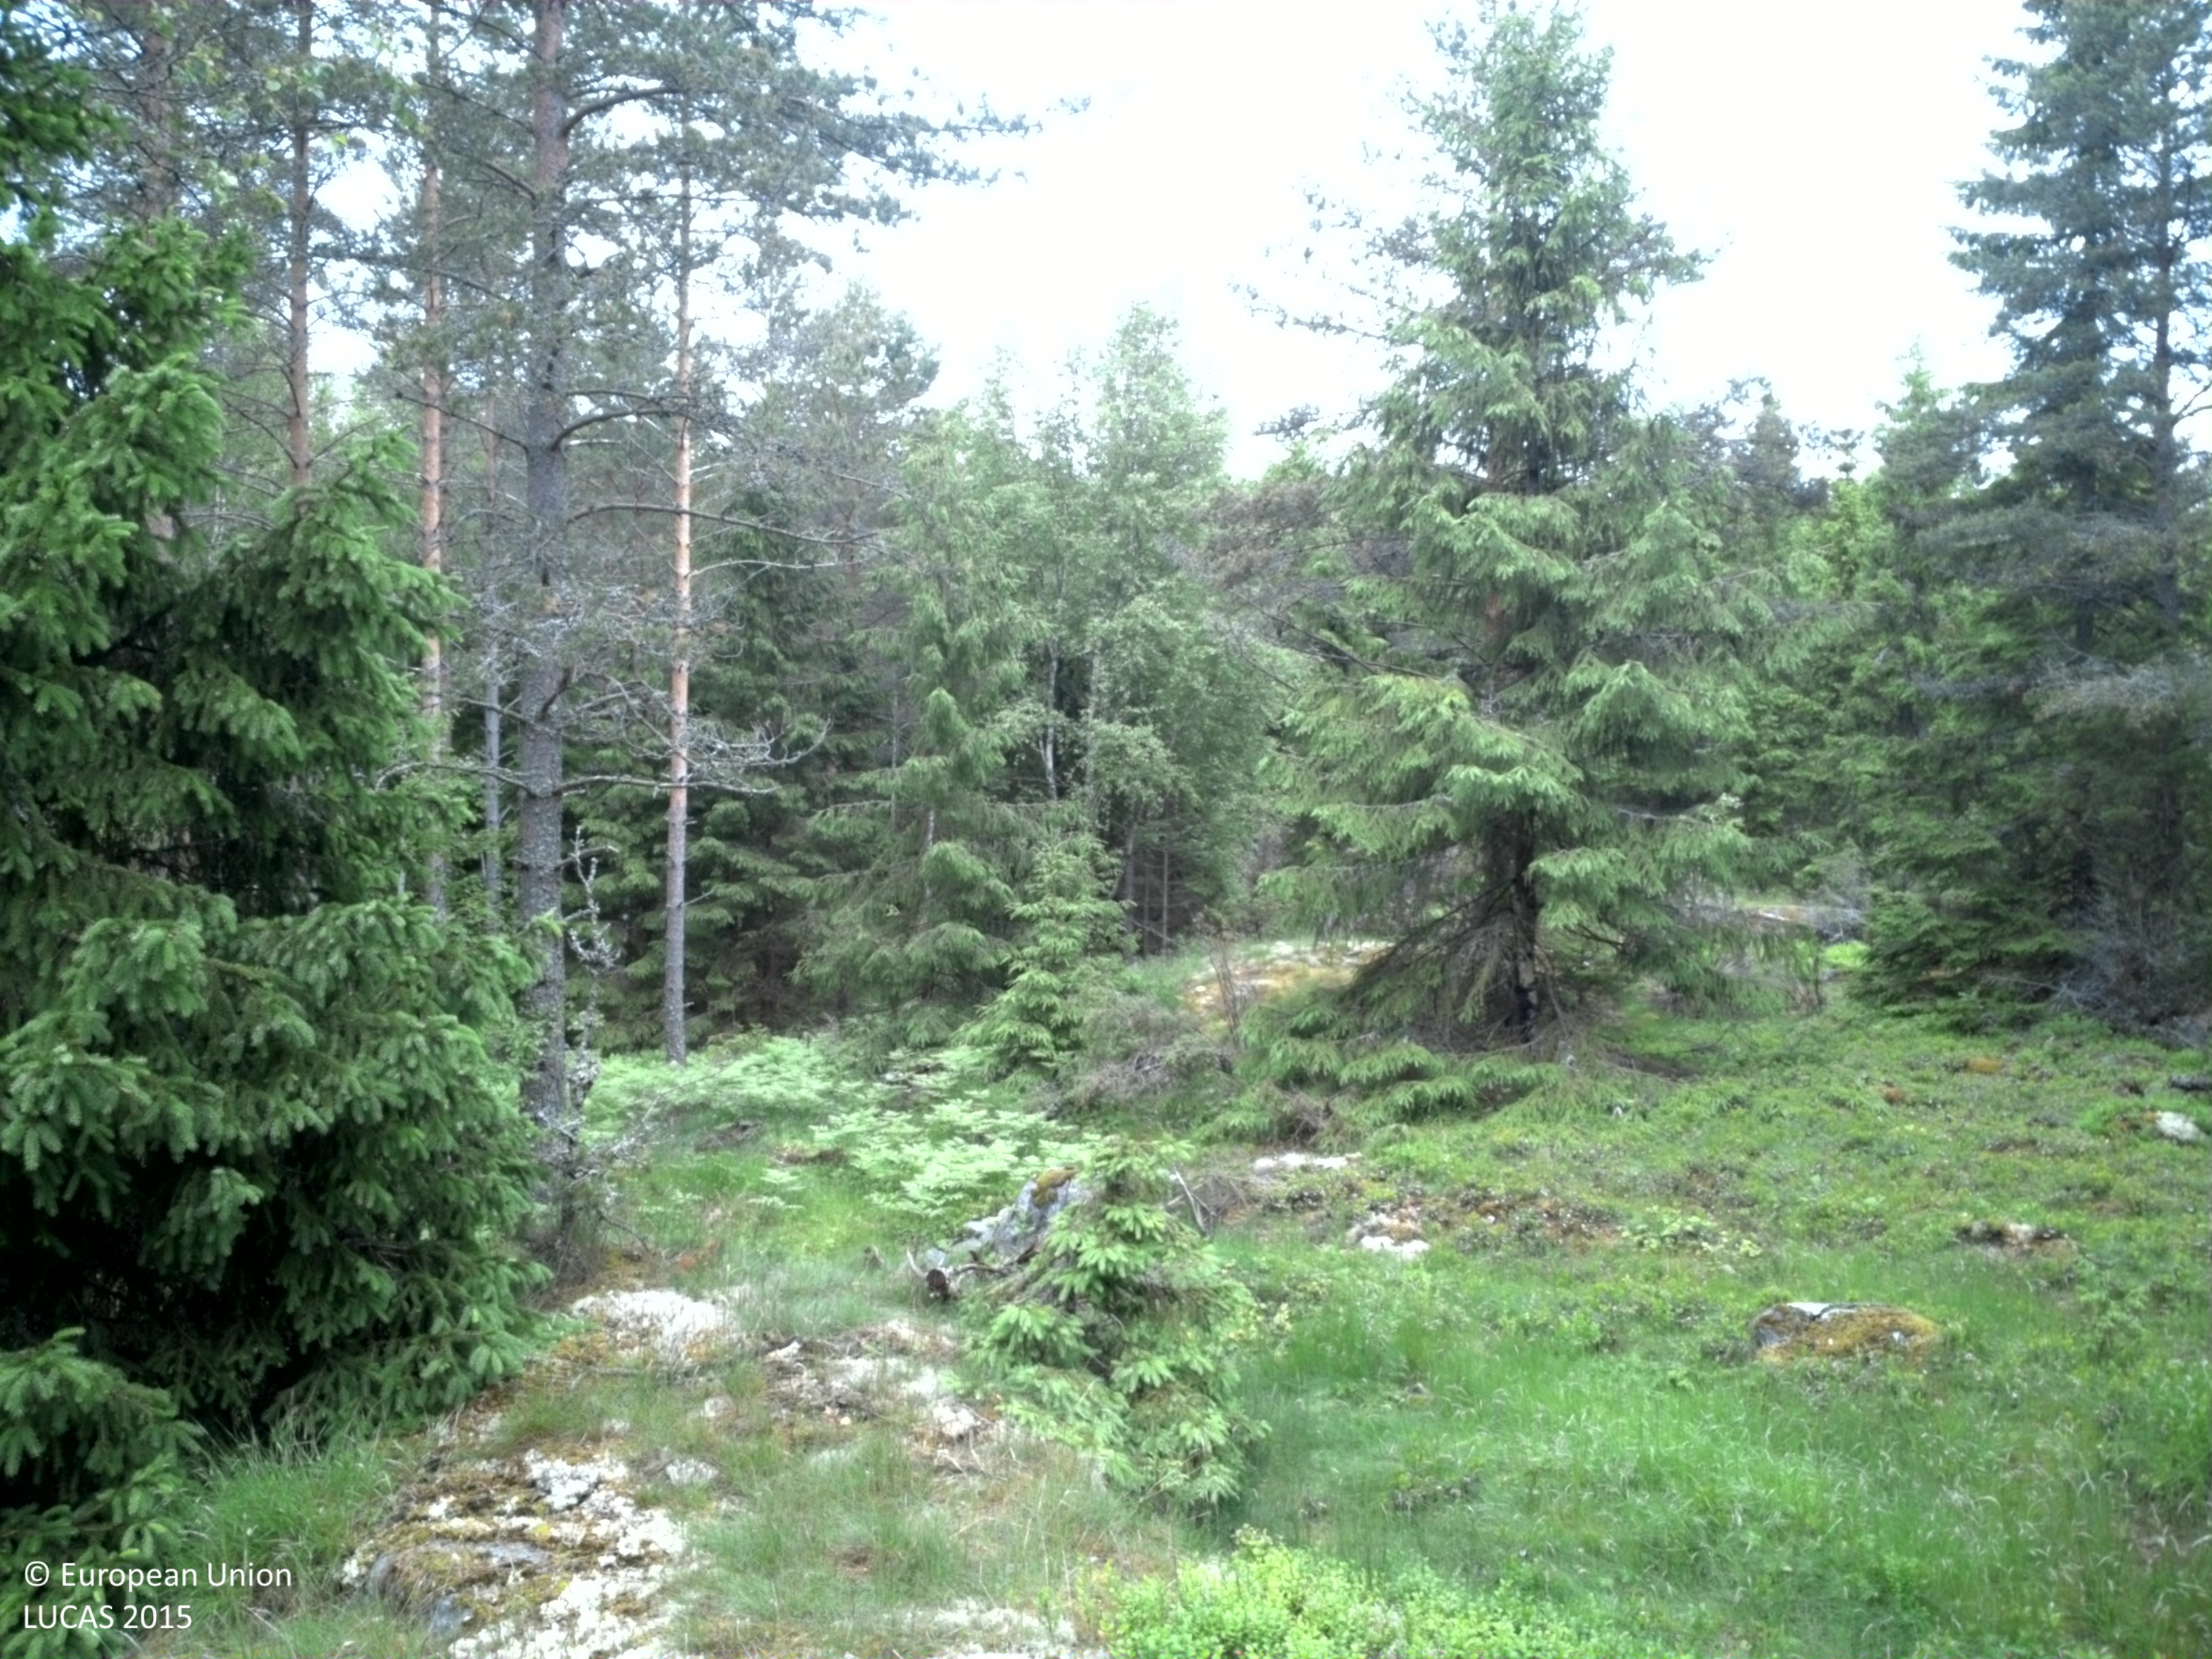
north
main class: Woodland
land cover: Pine dominated coniferous woodland
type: boreal forest
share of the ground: 10 - 25 %
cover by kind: herbaceous plants 25 %, lichens and mosses 25 %, consolidated bare surface 25 %, coniferous forest trees 20 %, broadleaved forest trees 5 %
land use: Forestry
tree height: > 5 m
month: June
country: SE
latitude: 59.6993
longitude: 18.6178
